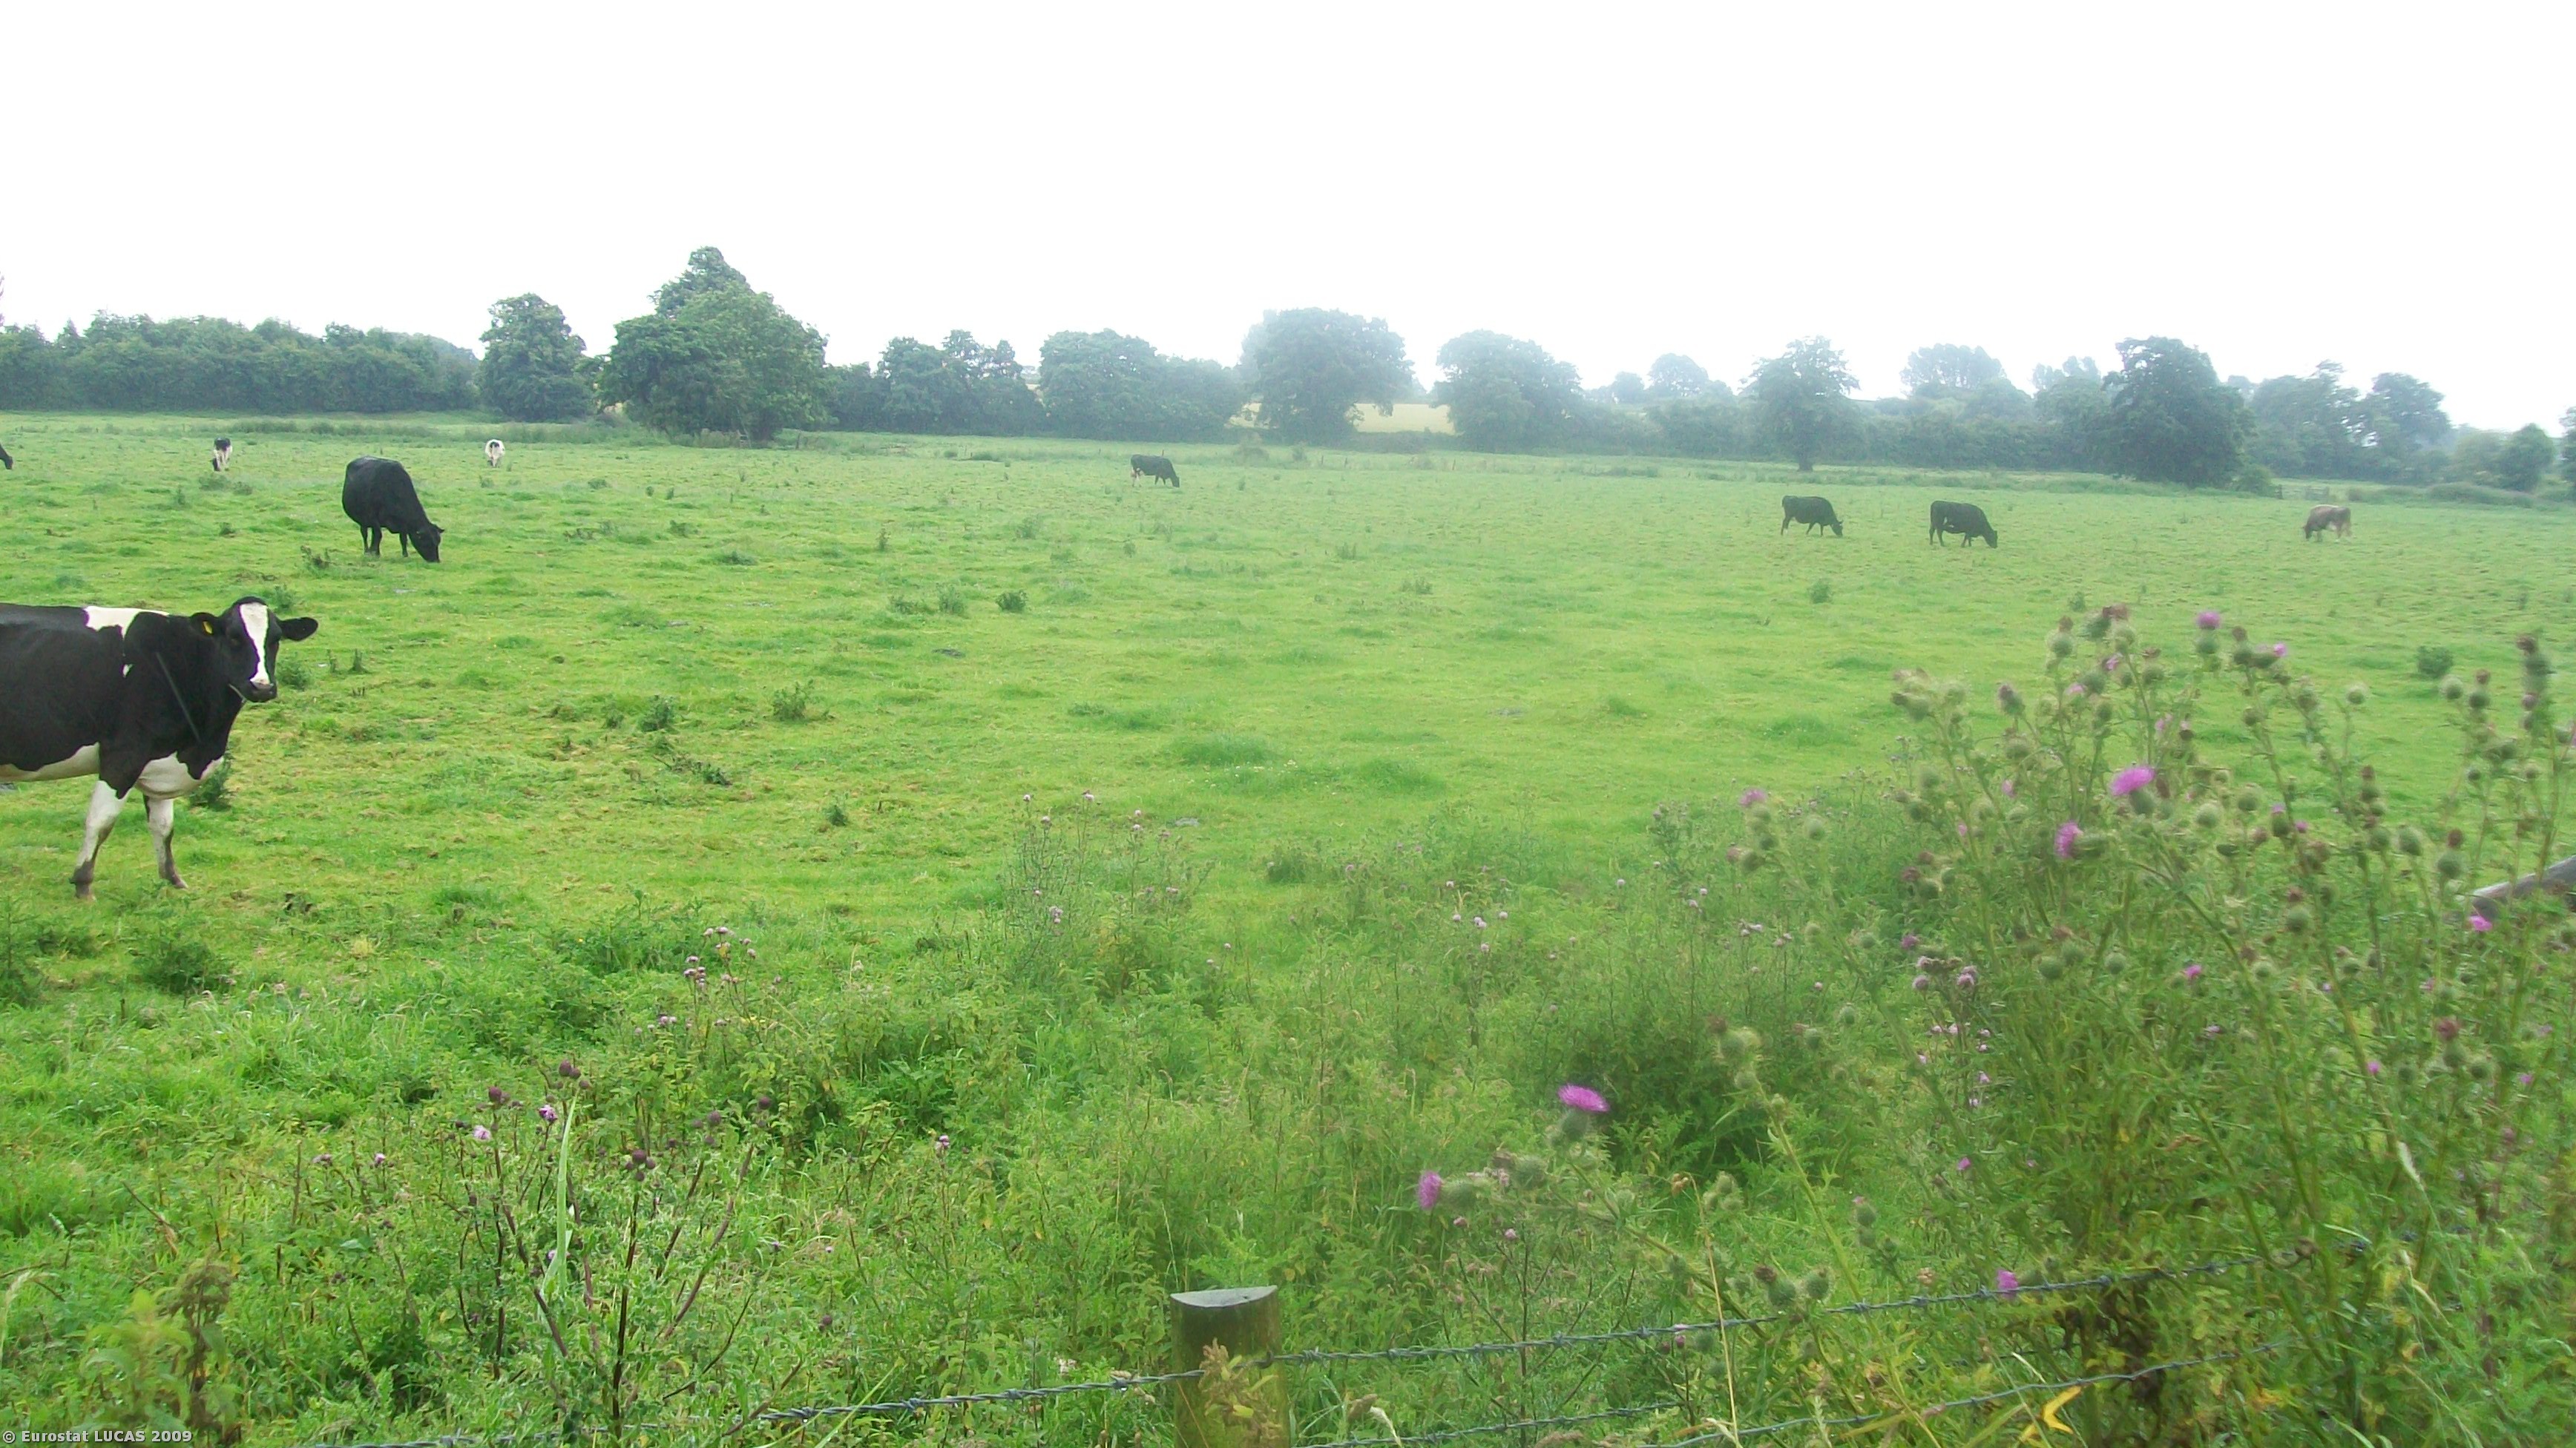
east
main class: Grassland
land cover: Grassland without tree/shrub cover
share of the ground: > 75 %
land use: Agriculture (excluding fallow land and kitchen gardens)
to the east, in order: Grassland without tree/shrub cover; Inland running water; Railways; Arable land (only in case pi); Managed hedges; Grassland without tree/shrub cover
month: July
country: GB
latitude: 52.9333
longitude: -2.6703
